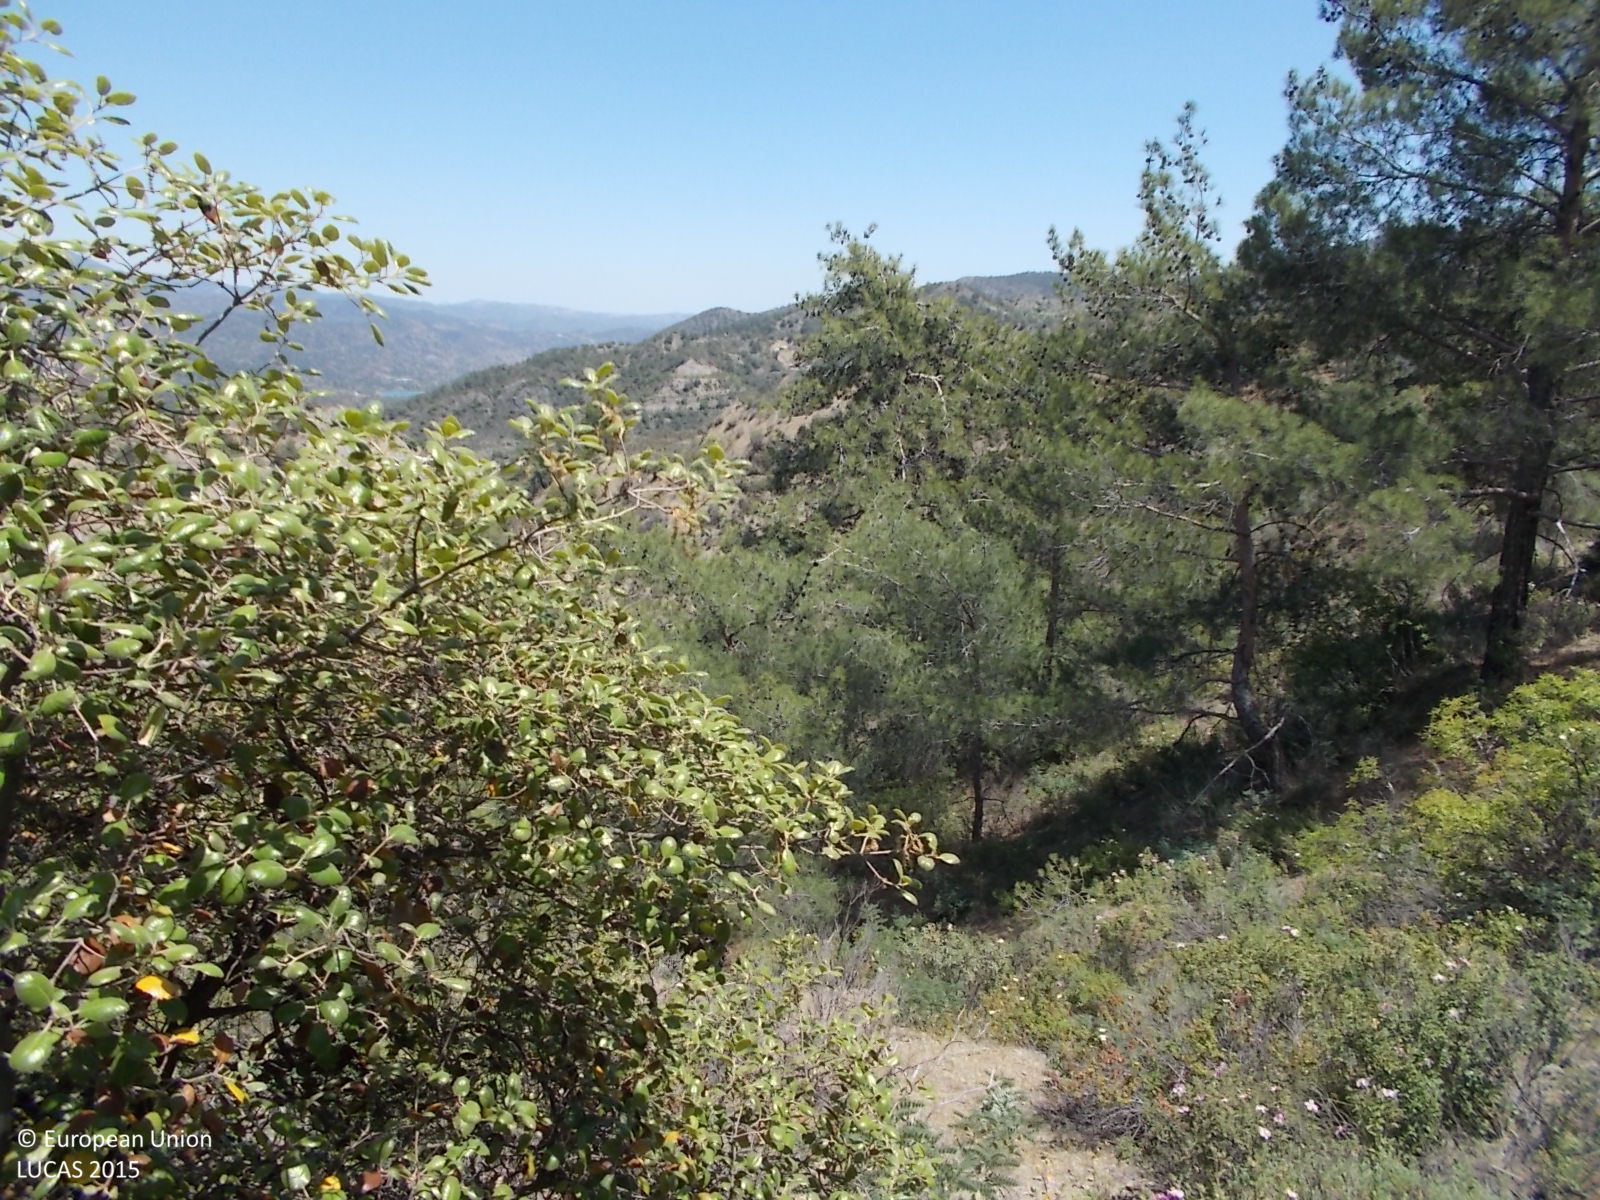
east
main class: Woodland
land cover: Pine dominated coniferous woodland
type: coniferous forest of the mediterranean region
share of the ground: 25 - 50 %
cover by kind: coniferous forest trees 40 %, shrubs 40 %, unconsolidated bare surface 20 %
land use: Semi-natural and natural areas not in use
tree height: > 5 m
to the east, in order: Pine dominated coniferous woodland; Shrubland with sparse tree cover; Pine dominated coniferous woodland; Electric lines; Pine dominated coniferous woodland; Shrubland with sparse tree cover; Shrubland without tree cover; Tracks
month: May
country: CY
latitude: 34.8409
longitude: 33.0364
